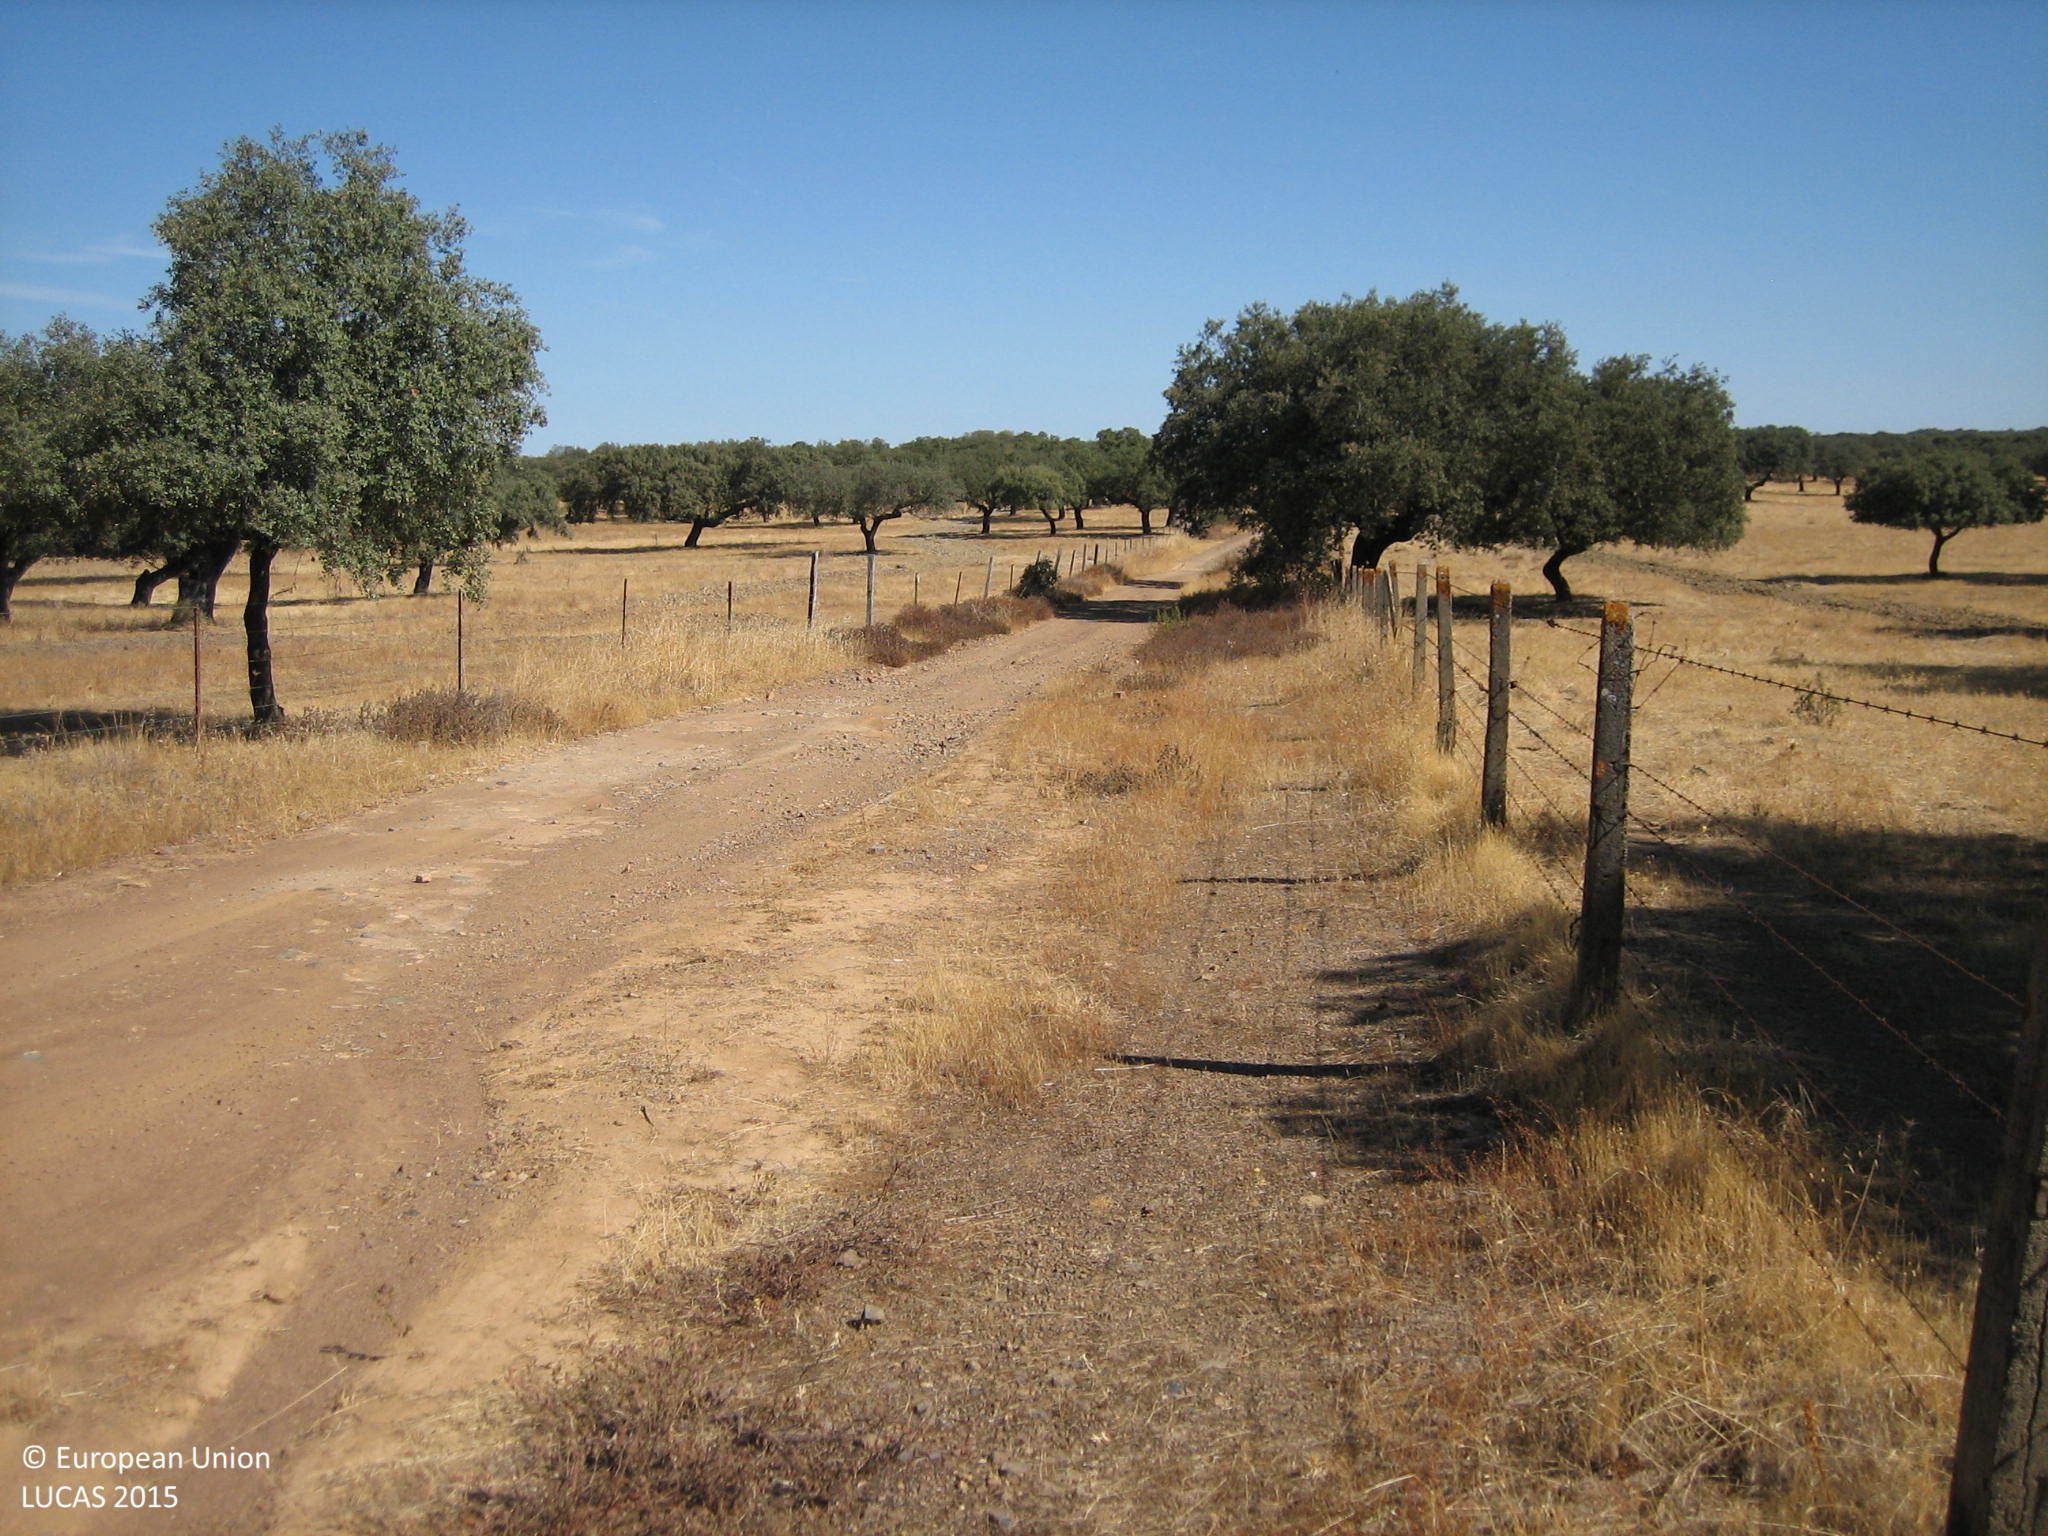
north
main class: Woodland
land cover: Broadleaved woodland
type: broadleaved evergreen forest
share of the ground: 50 - 75 %
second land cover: Grassland without tree/shrub cover
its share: > 75 %
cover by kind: broadleaved forest trees 50 %, herbaceous plants 50 %
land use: Forestry
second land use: Agriculture (excluding fallow land and kitchen gardens)
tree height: > 5 m
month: August
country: ES
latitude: 38.4058
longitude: -7.1856
